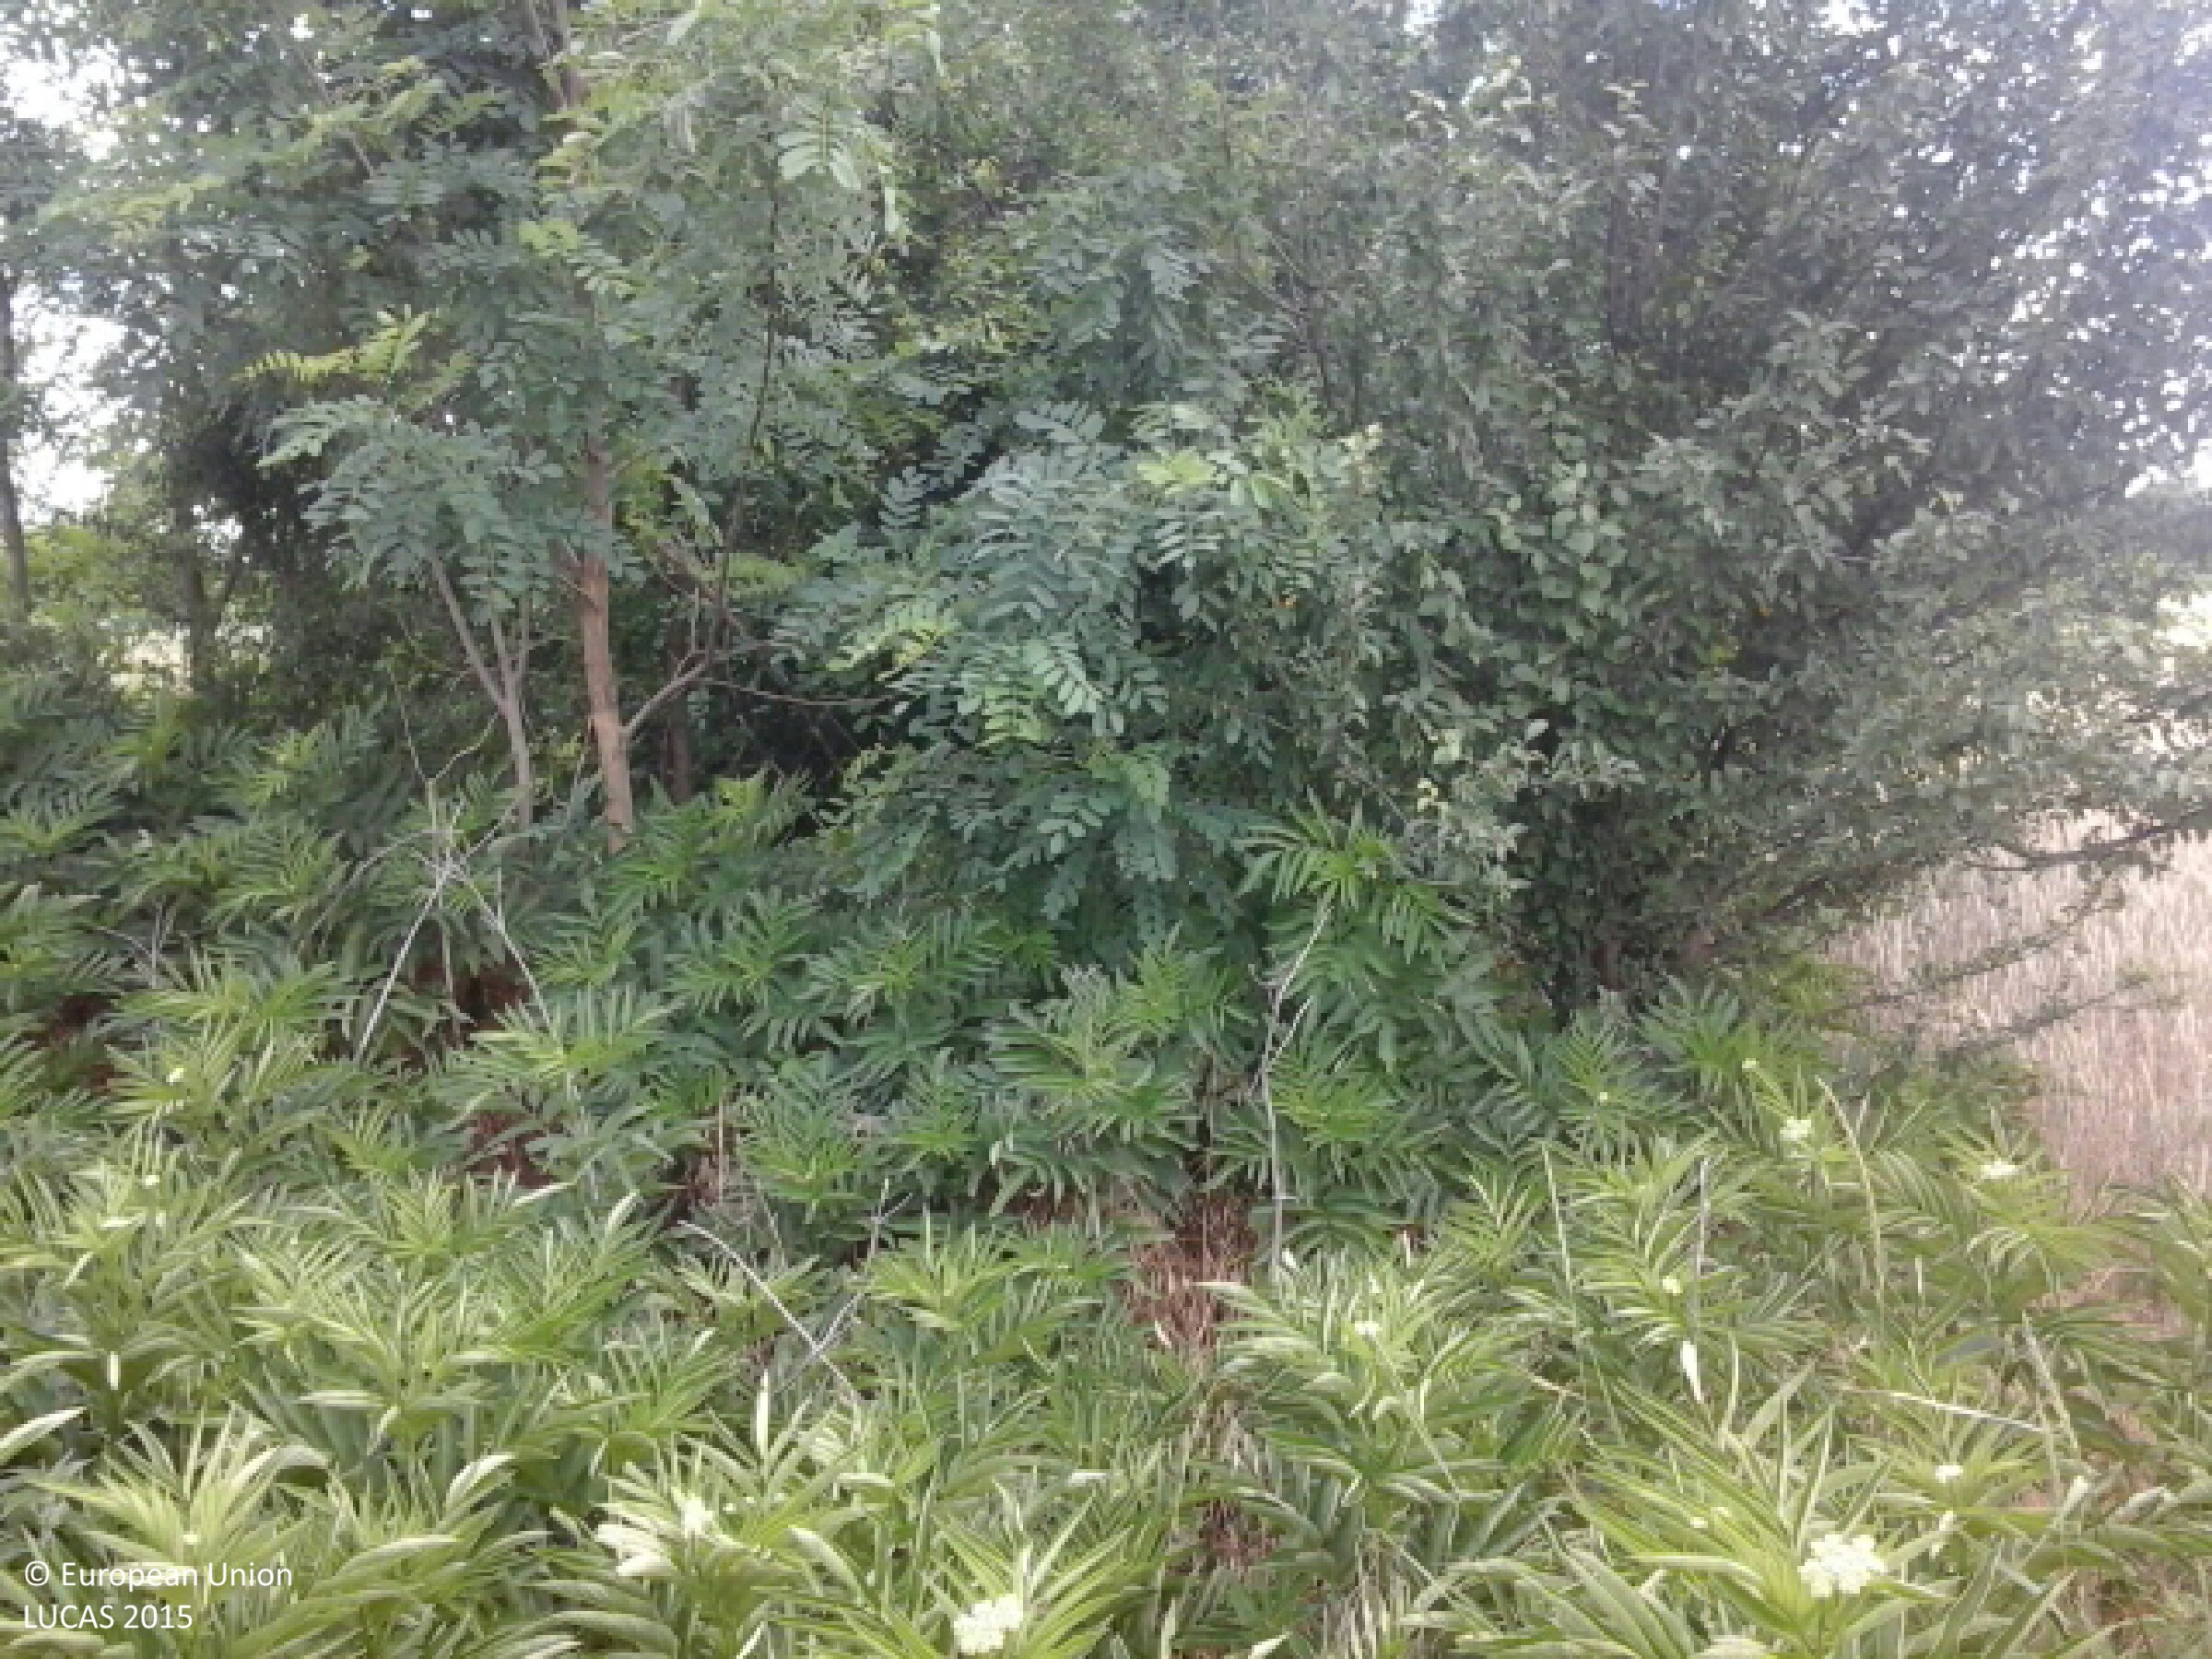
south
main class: Grassland
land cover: Spontaneously vegetated surfaces
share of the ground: > 75 %
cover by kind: herbaceous plants 95 %, shrubs 5 %
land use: Semi-natural and natural areas not in use
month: June
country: HU
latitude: 48.0697
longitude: 21.7108
